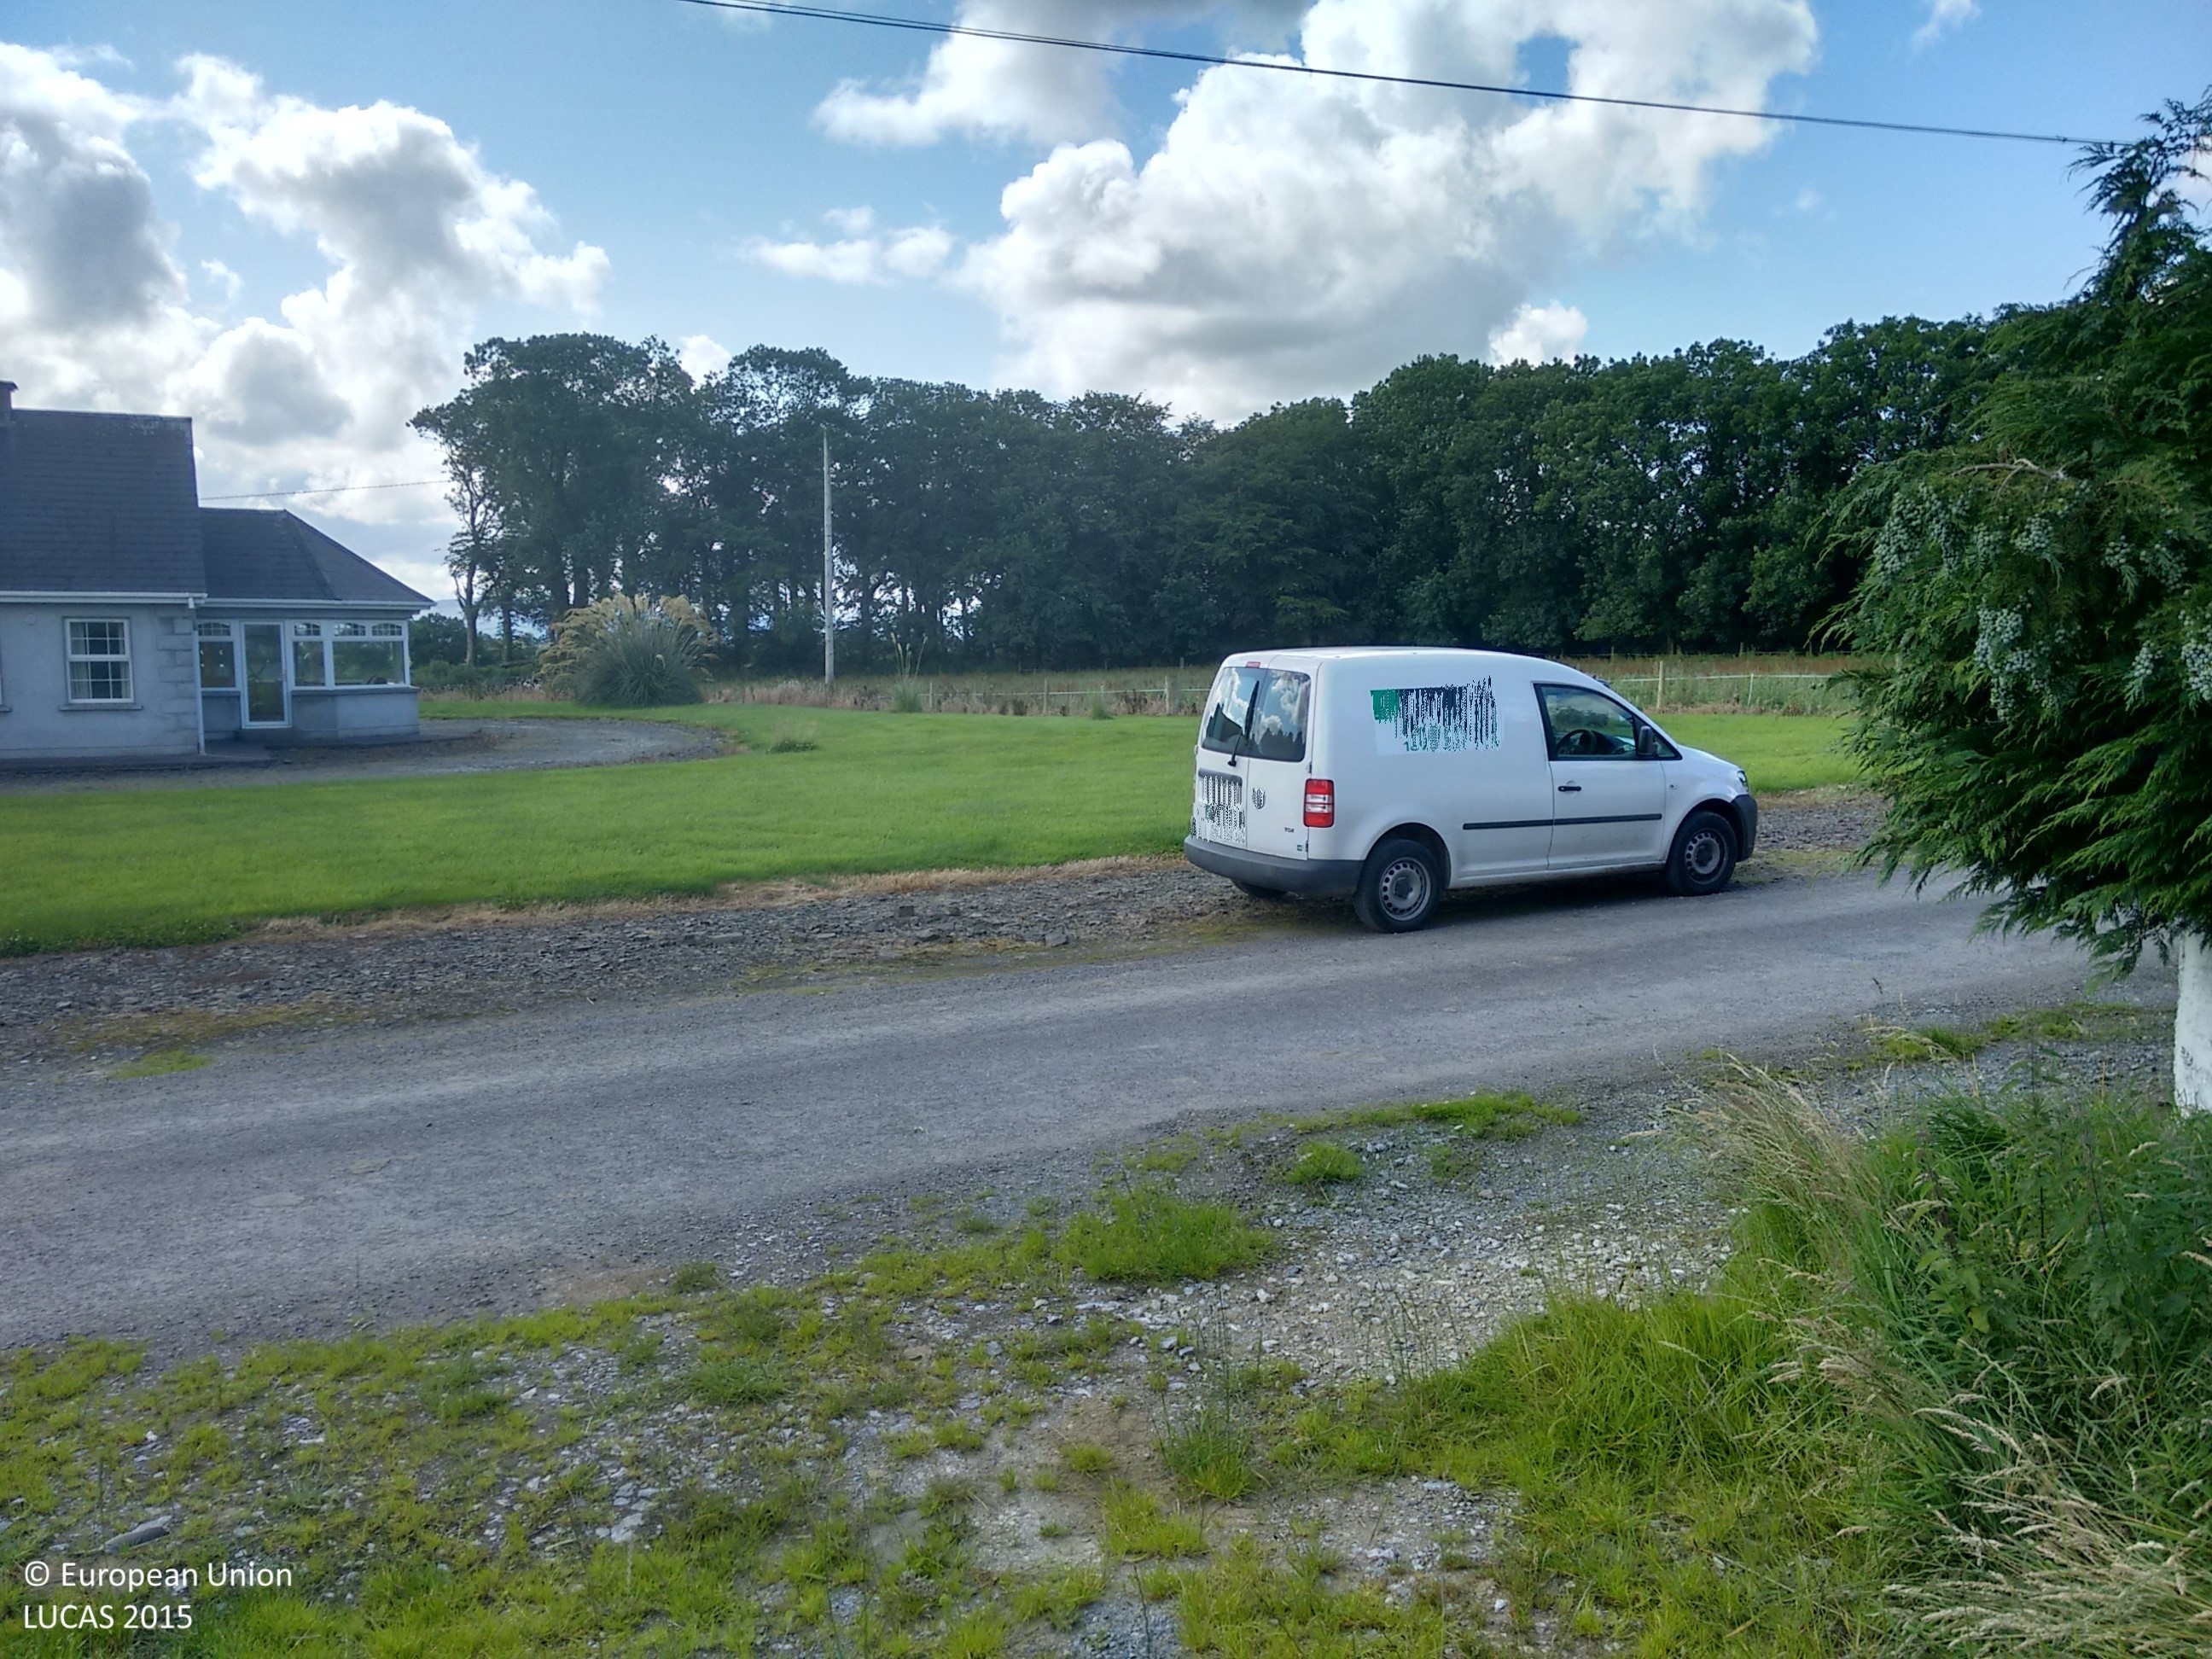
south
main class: Cropland
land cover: Barley
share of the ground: > 75 %
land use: Agriculture (excluding fallow land and kitchen gardens)
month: July
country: IE
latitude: 52.2203
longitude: -8.9323
